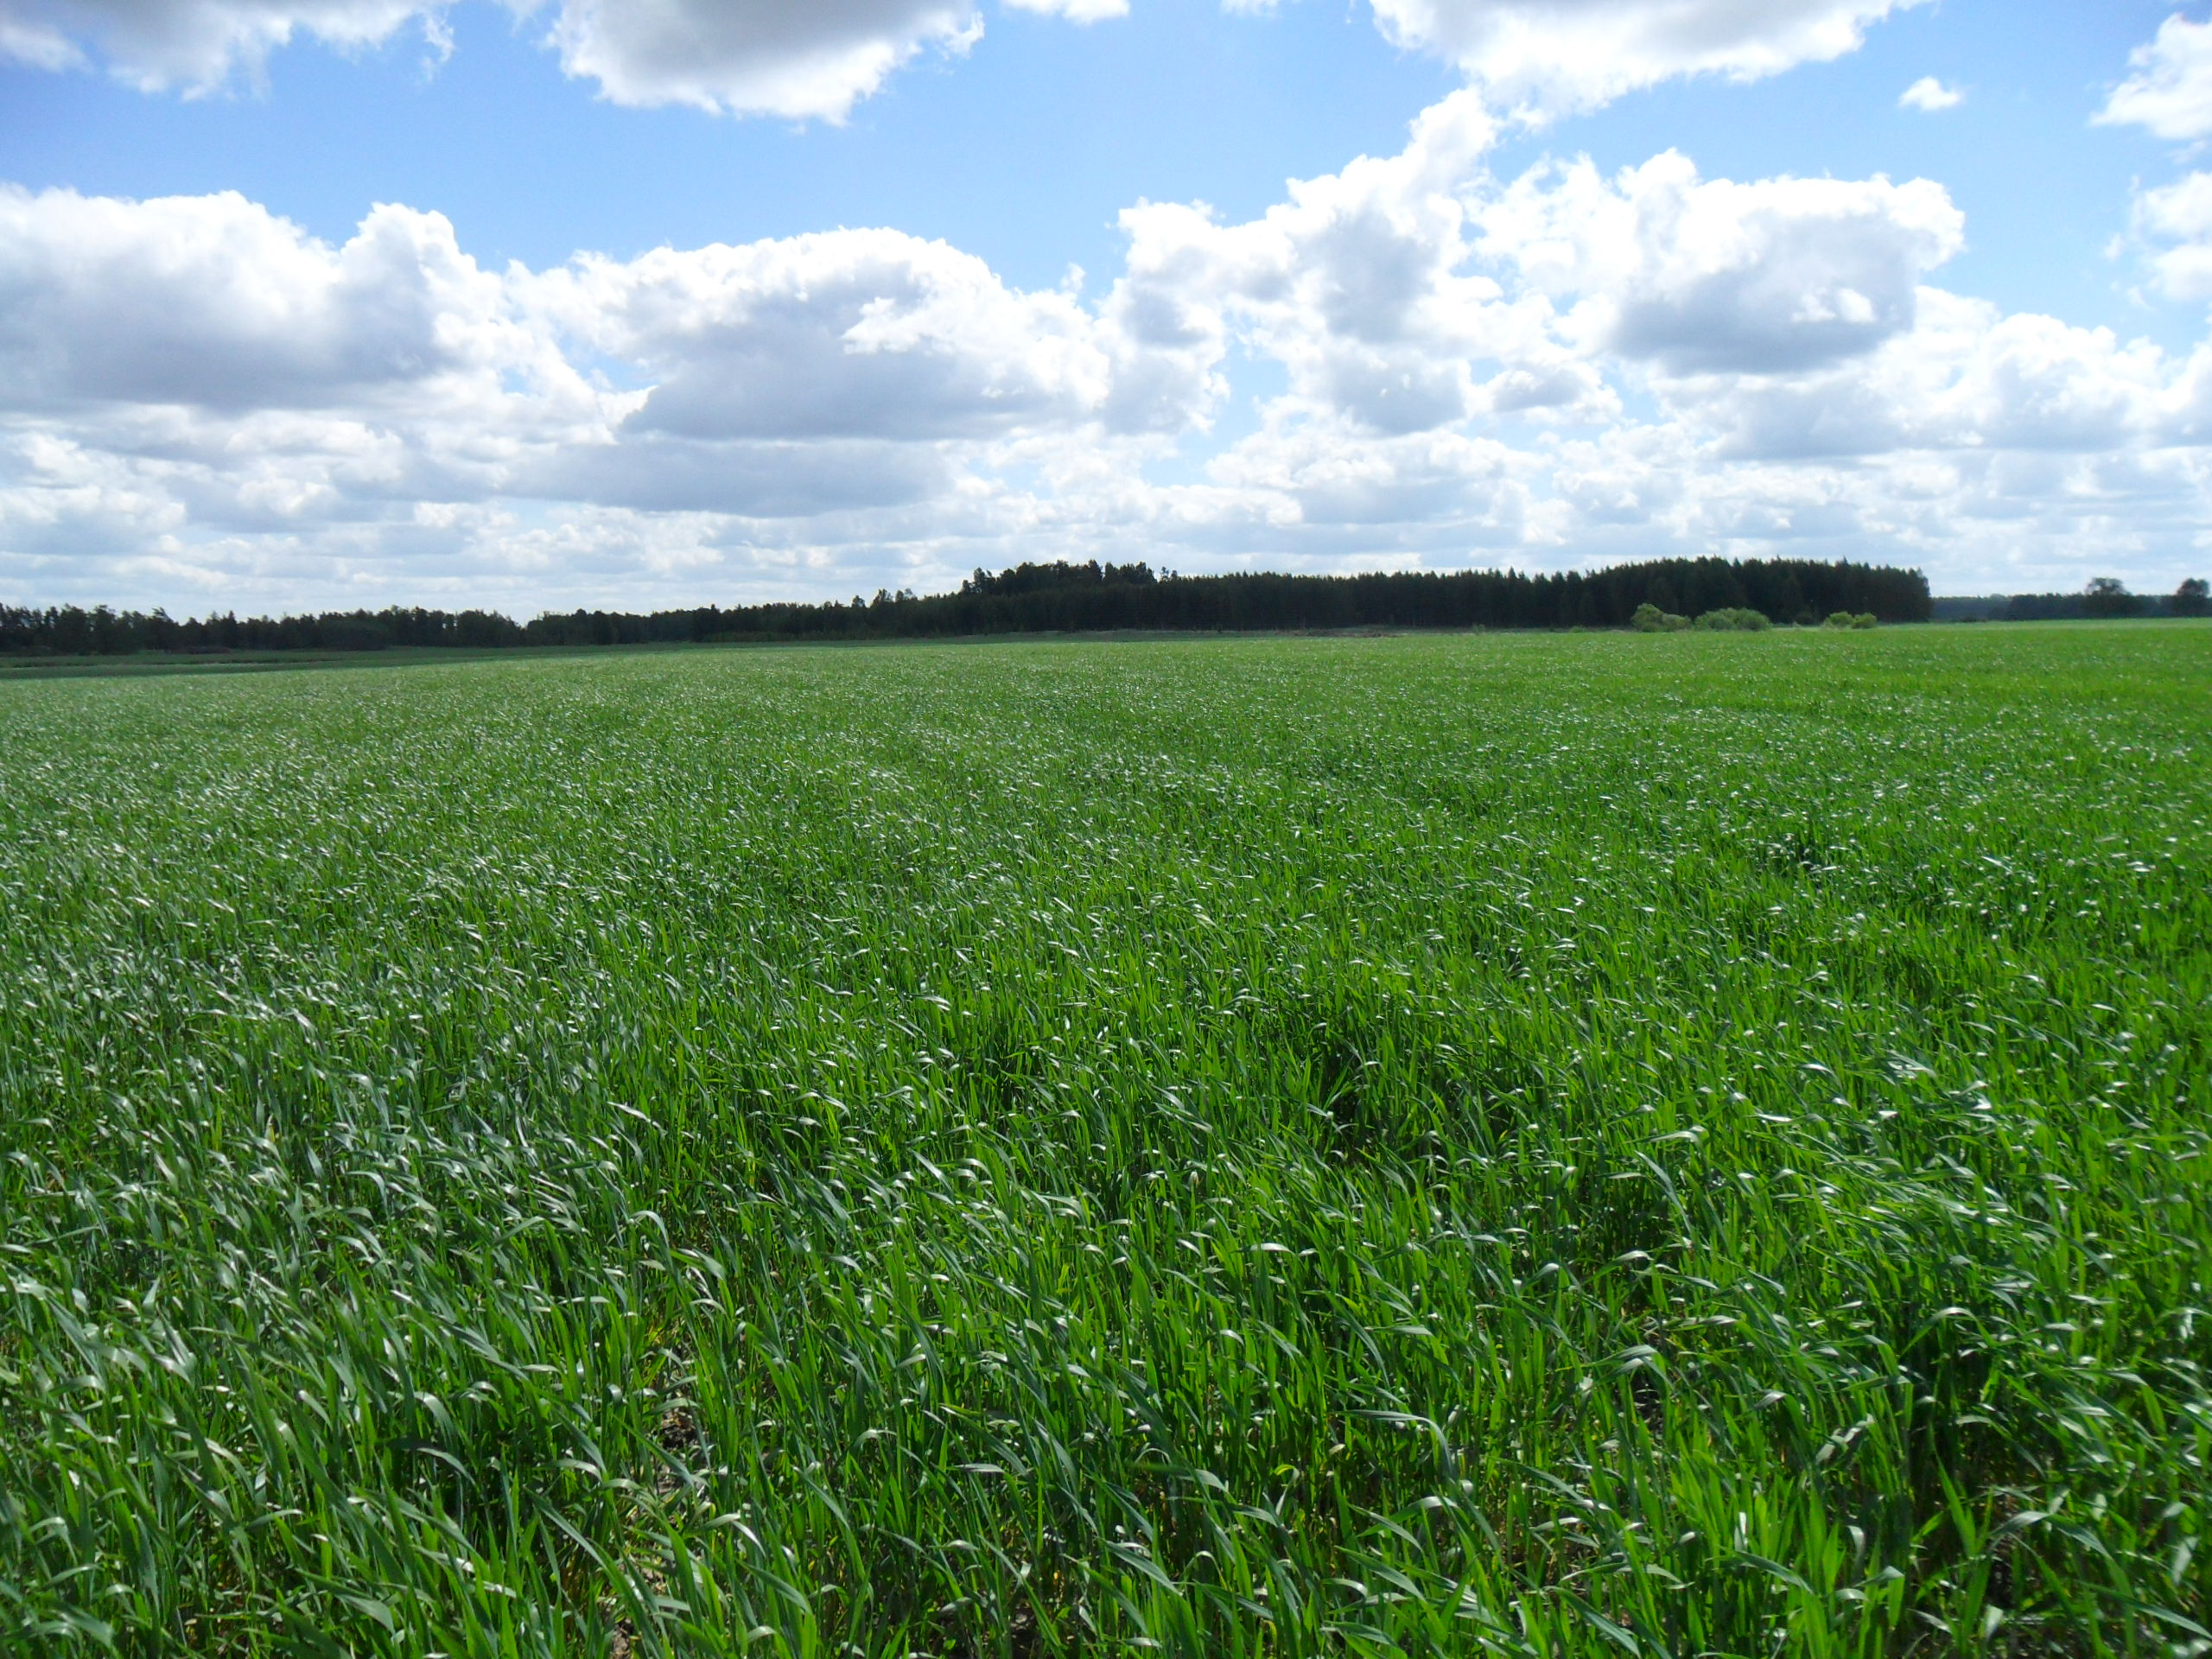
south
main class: Cropland
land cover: Common wheat
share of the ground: > 75 %
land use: Agriculture (excluding fallow land and kitchen gardens)
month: June
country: LV
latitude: 57.0755
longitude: 22.9794
